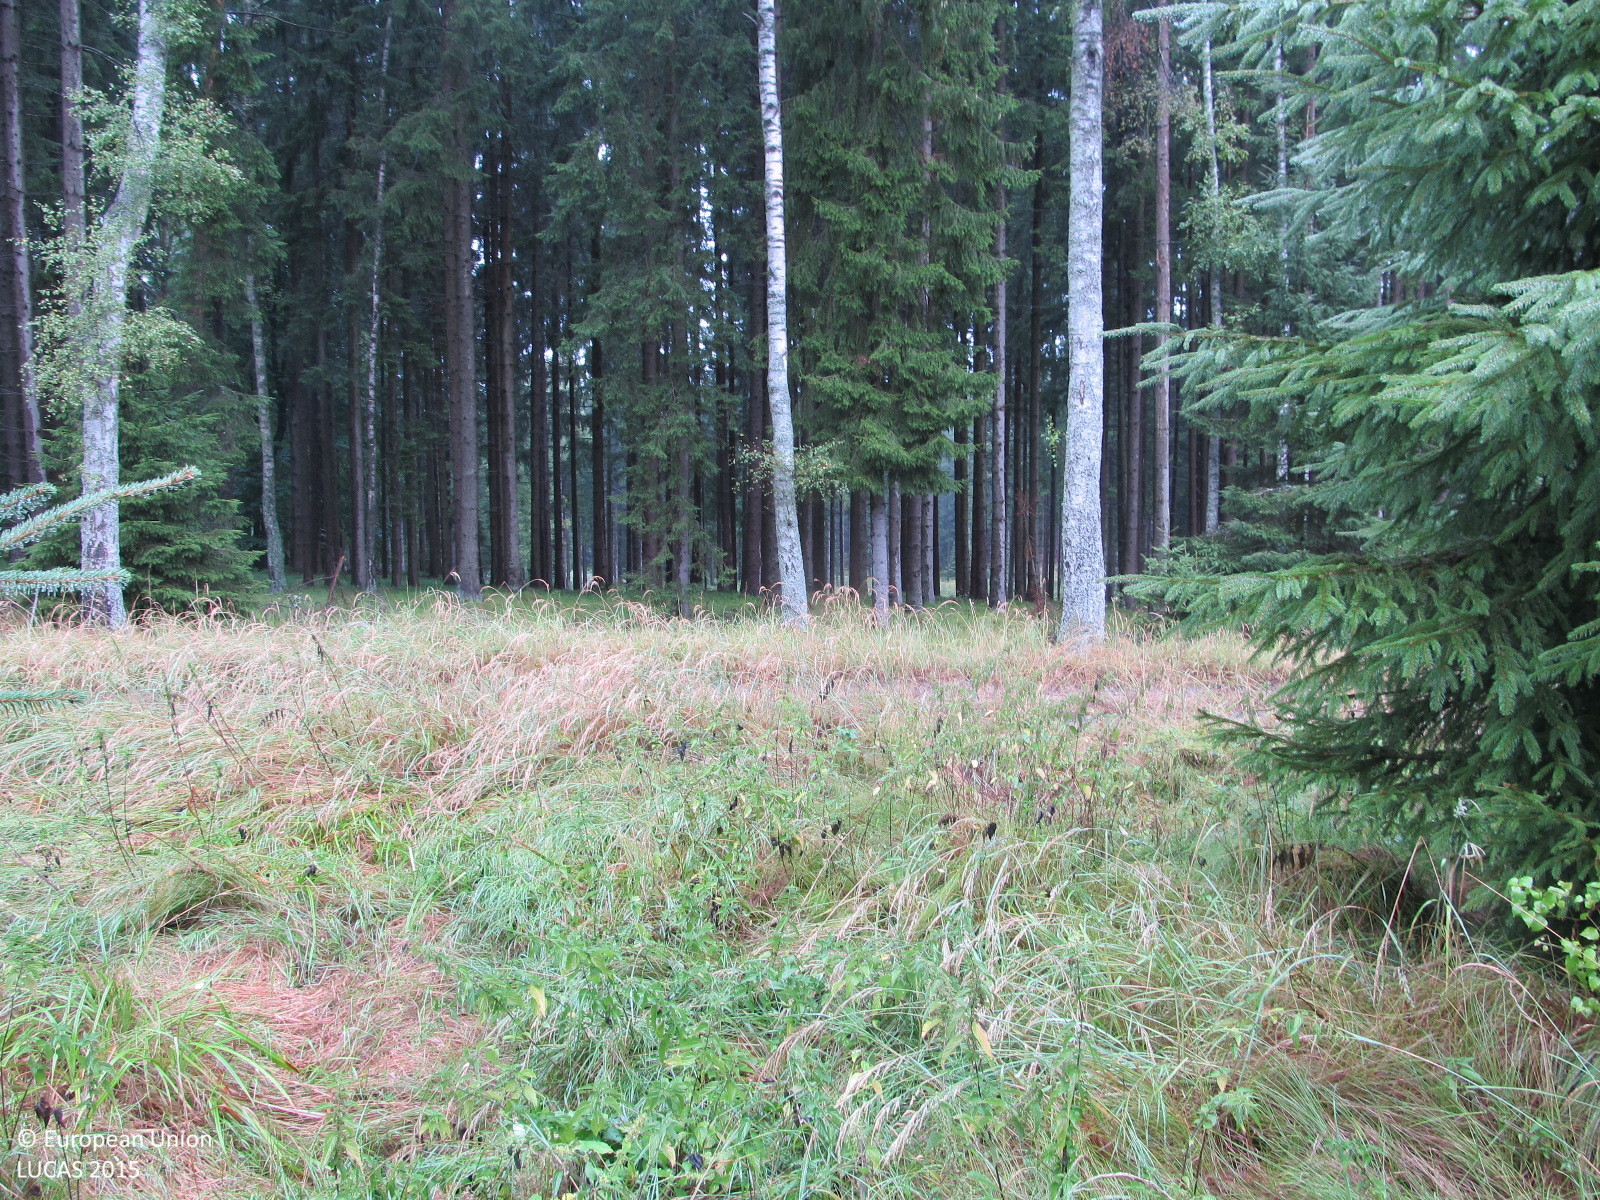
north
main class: Woodland
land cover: Spruce dominated coniferous woodland
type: hemiboreal forest and nemoral coniferous forest and mixed broadleaved-coniferous forest
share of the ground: > 75 %
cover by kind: coniferous forest trees 80 %, herbaceous plants 20 %
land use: Forestry
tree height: > 5 m
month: August
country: AT
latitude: 48.7006
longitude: 15.0973
